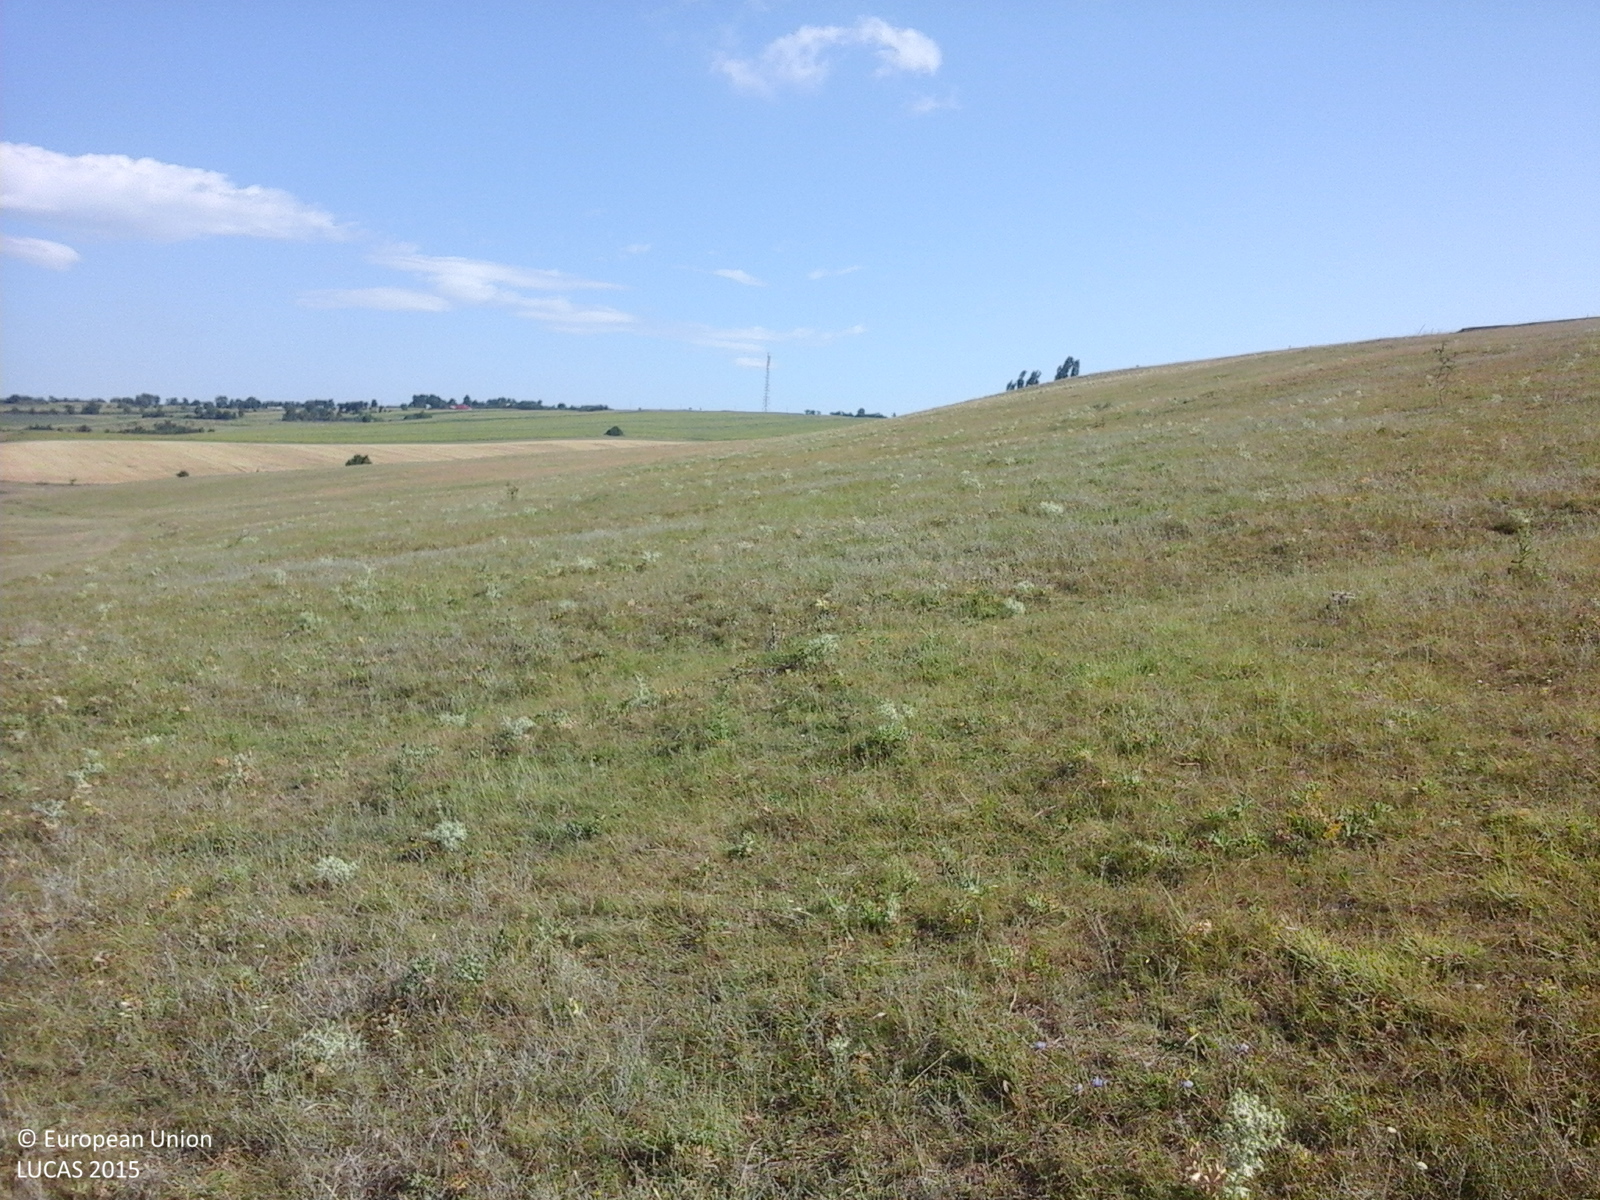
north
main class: Grassland
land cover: Grassland without tree/shrub cover
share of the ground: > 75 %
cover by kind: herbaceous plants 100 %
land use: Agriculture (excluding fallow land and kitchen gardens)
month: July
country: RO
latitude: 46.0696
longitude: 27.7362
